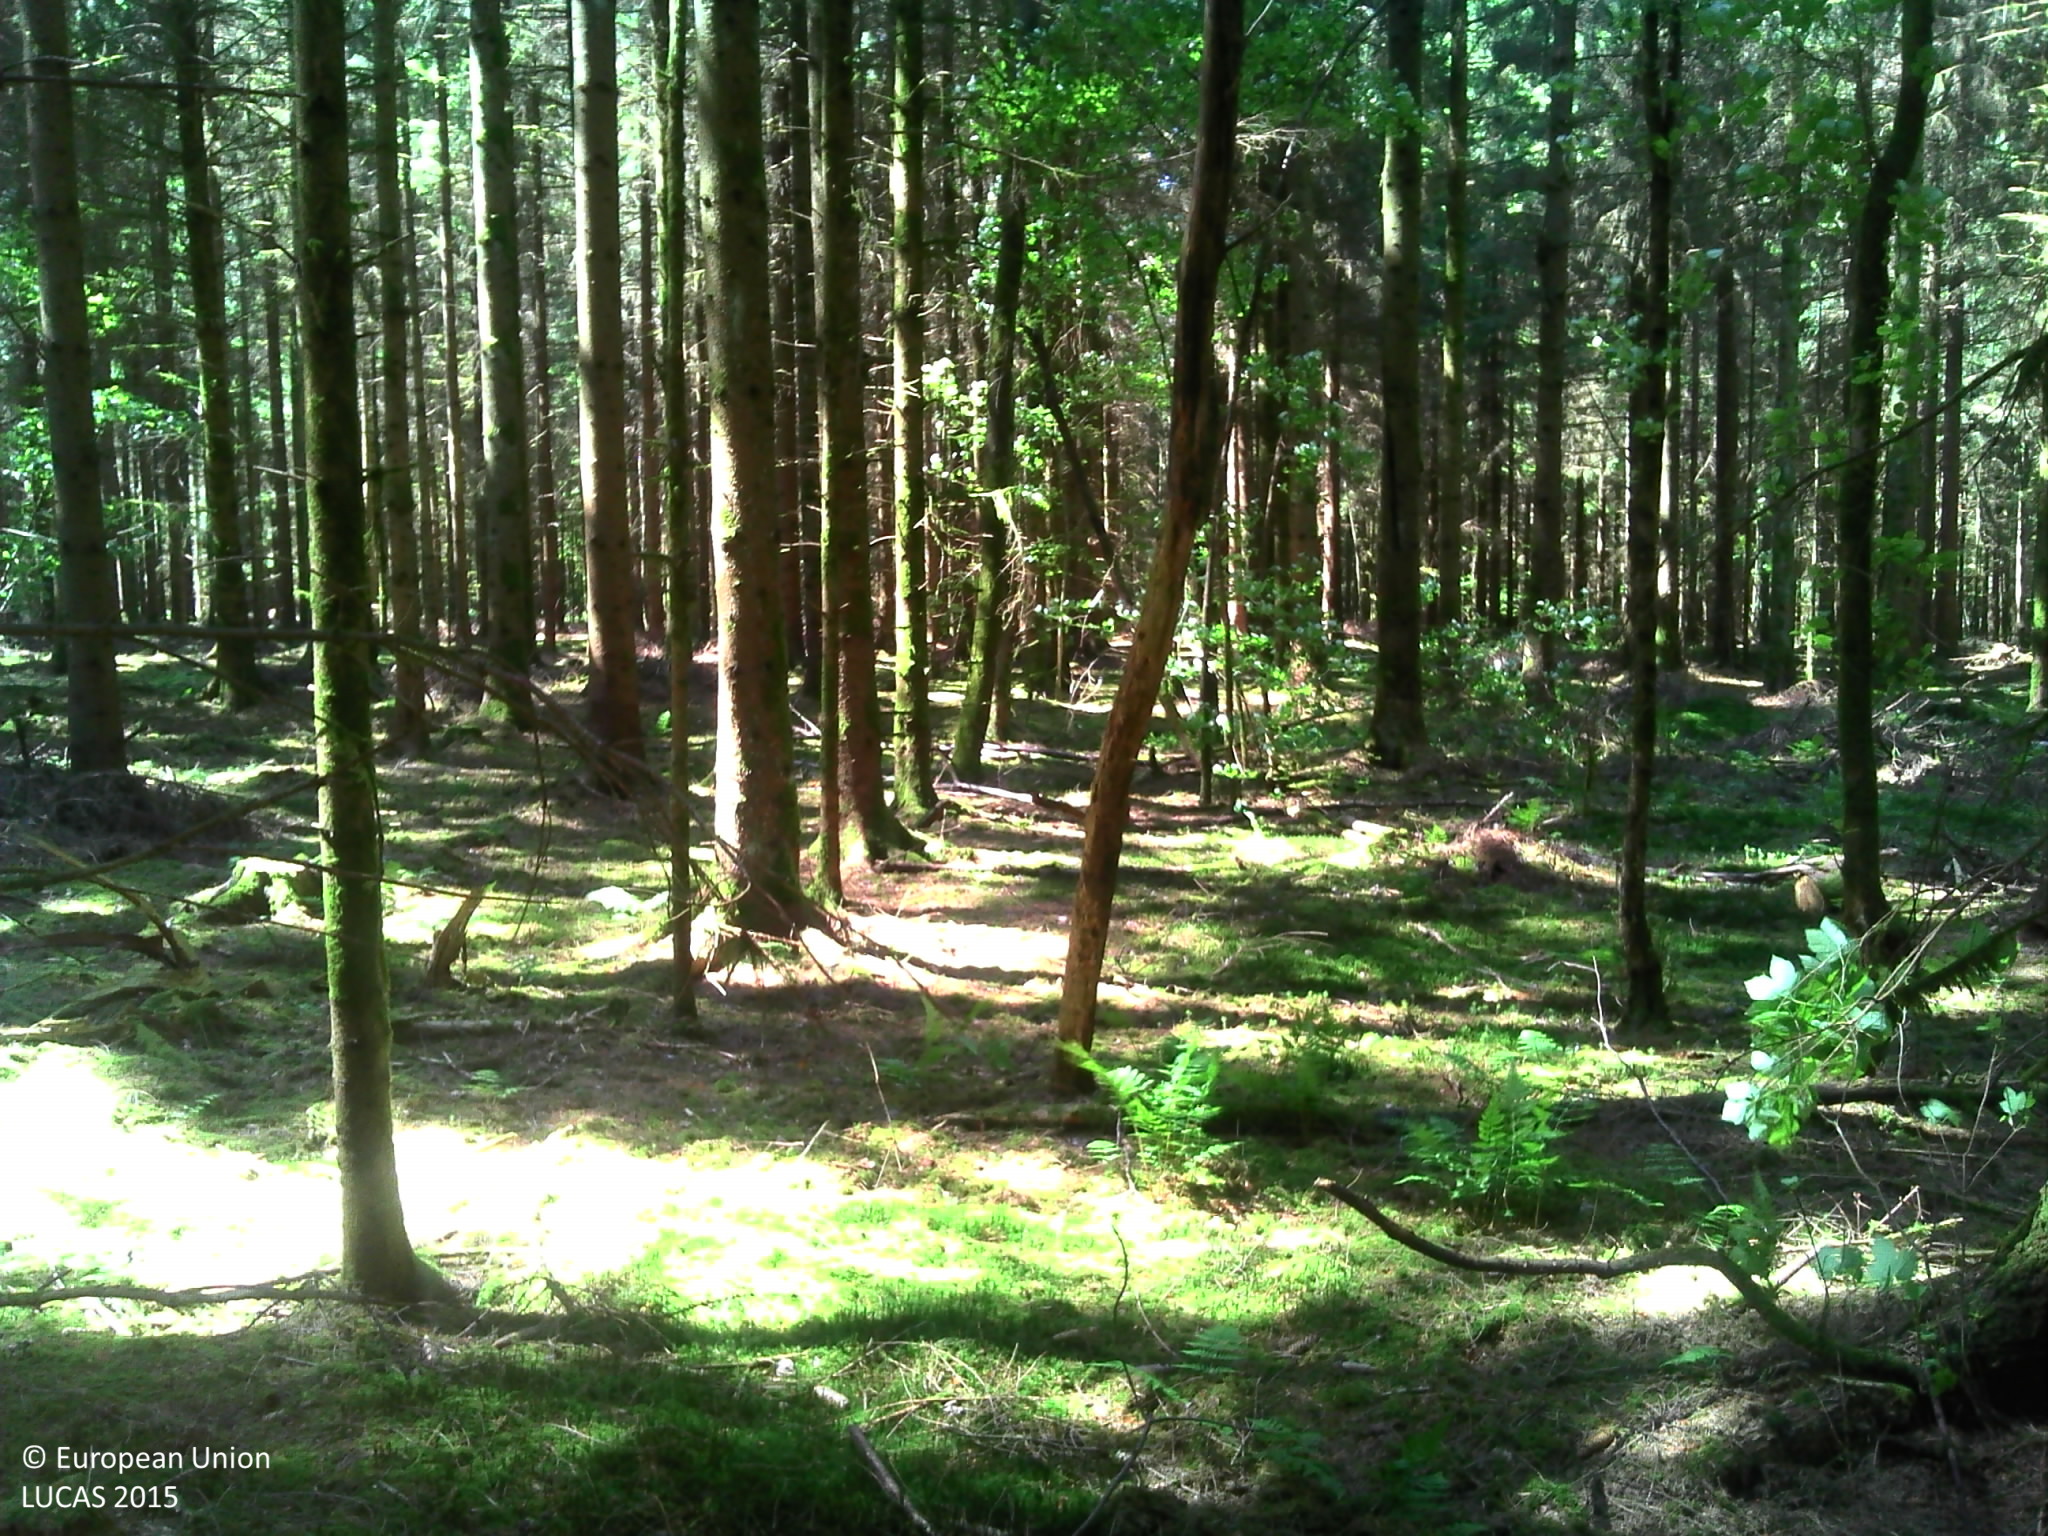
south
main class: Woodland
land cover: Spruce dominated coniferous woodland
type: exotic forest
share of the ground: > 75 %
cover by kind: coniferous forest trees 90 %, lichens and mosses 10 %
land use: Forestry
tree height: > 5 m
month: June
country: FR
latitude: 49.9636
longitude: 4.1818
